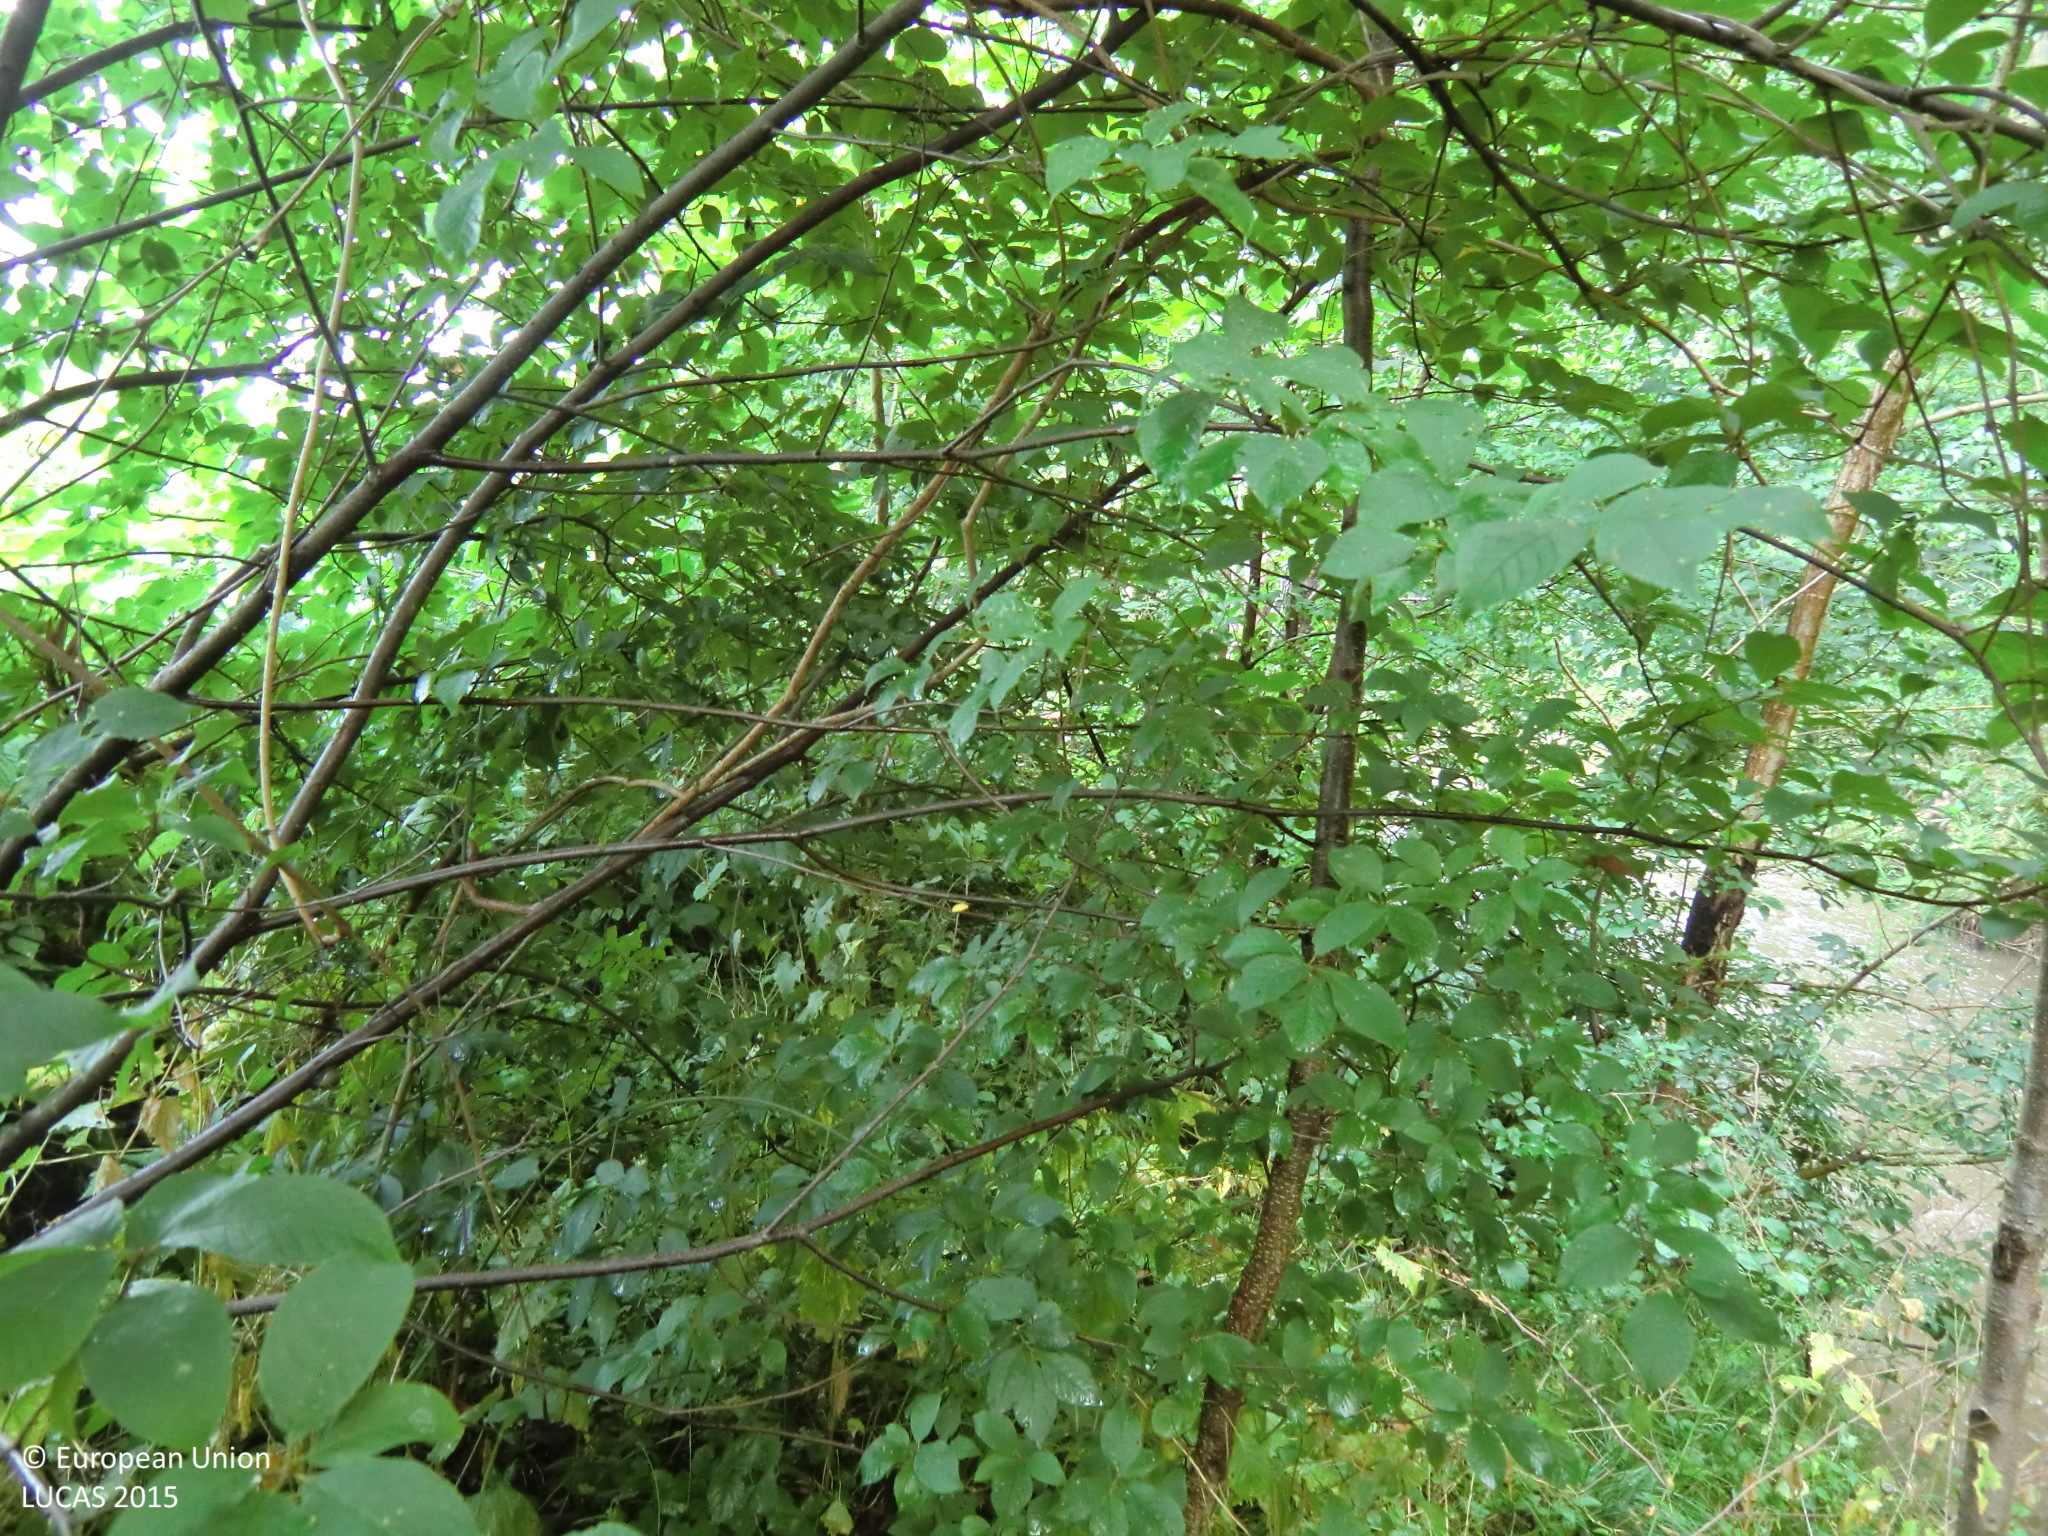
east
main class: Woodland
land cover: Broadleaved woodland
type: floodplain forest
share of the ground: > 75 %
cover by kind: broadleaved forest trees 90 %, herbaceous plants 10 %
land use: Semi-natural and natural areas not in use
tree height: > 5 m
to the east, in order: Broadleaved woodland; Inland fresh running water; Broadleaved woodland; Artificial constructions in urban areas
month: July
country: AT
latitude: 47.0765
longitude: 15.4918
